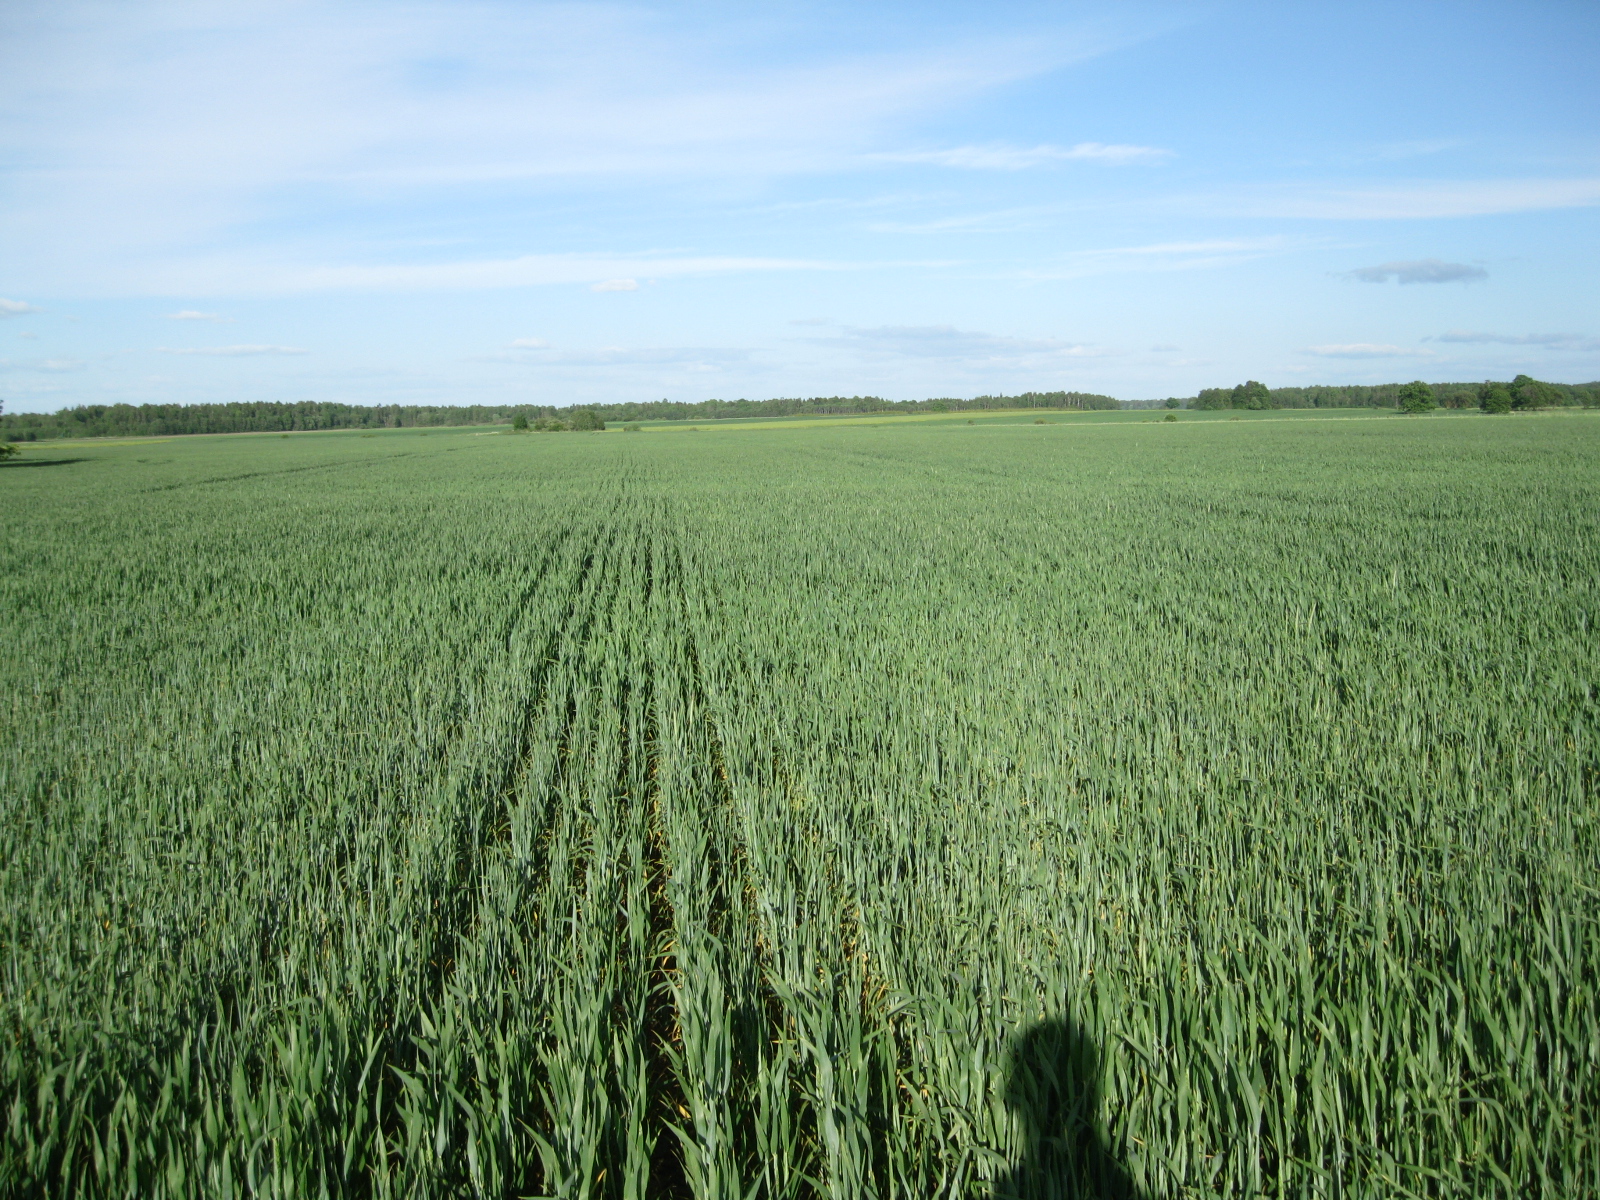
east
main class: Cropland
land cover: Common wheat
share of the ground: > 75 %
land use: Agriculture (excluding fallow land and kitchen gardens)
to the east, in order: Common wheat
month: June
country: LT
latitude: 55.5394
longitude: 23.5332
